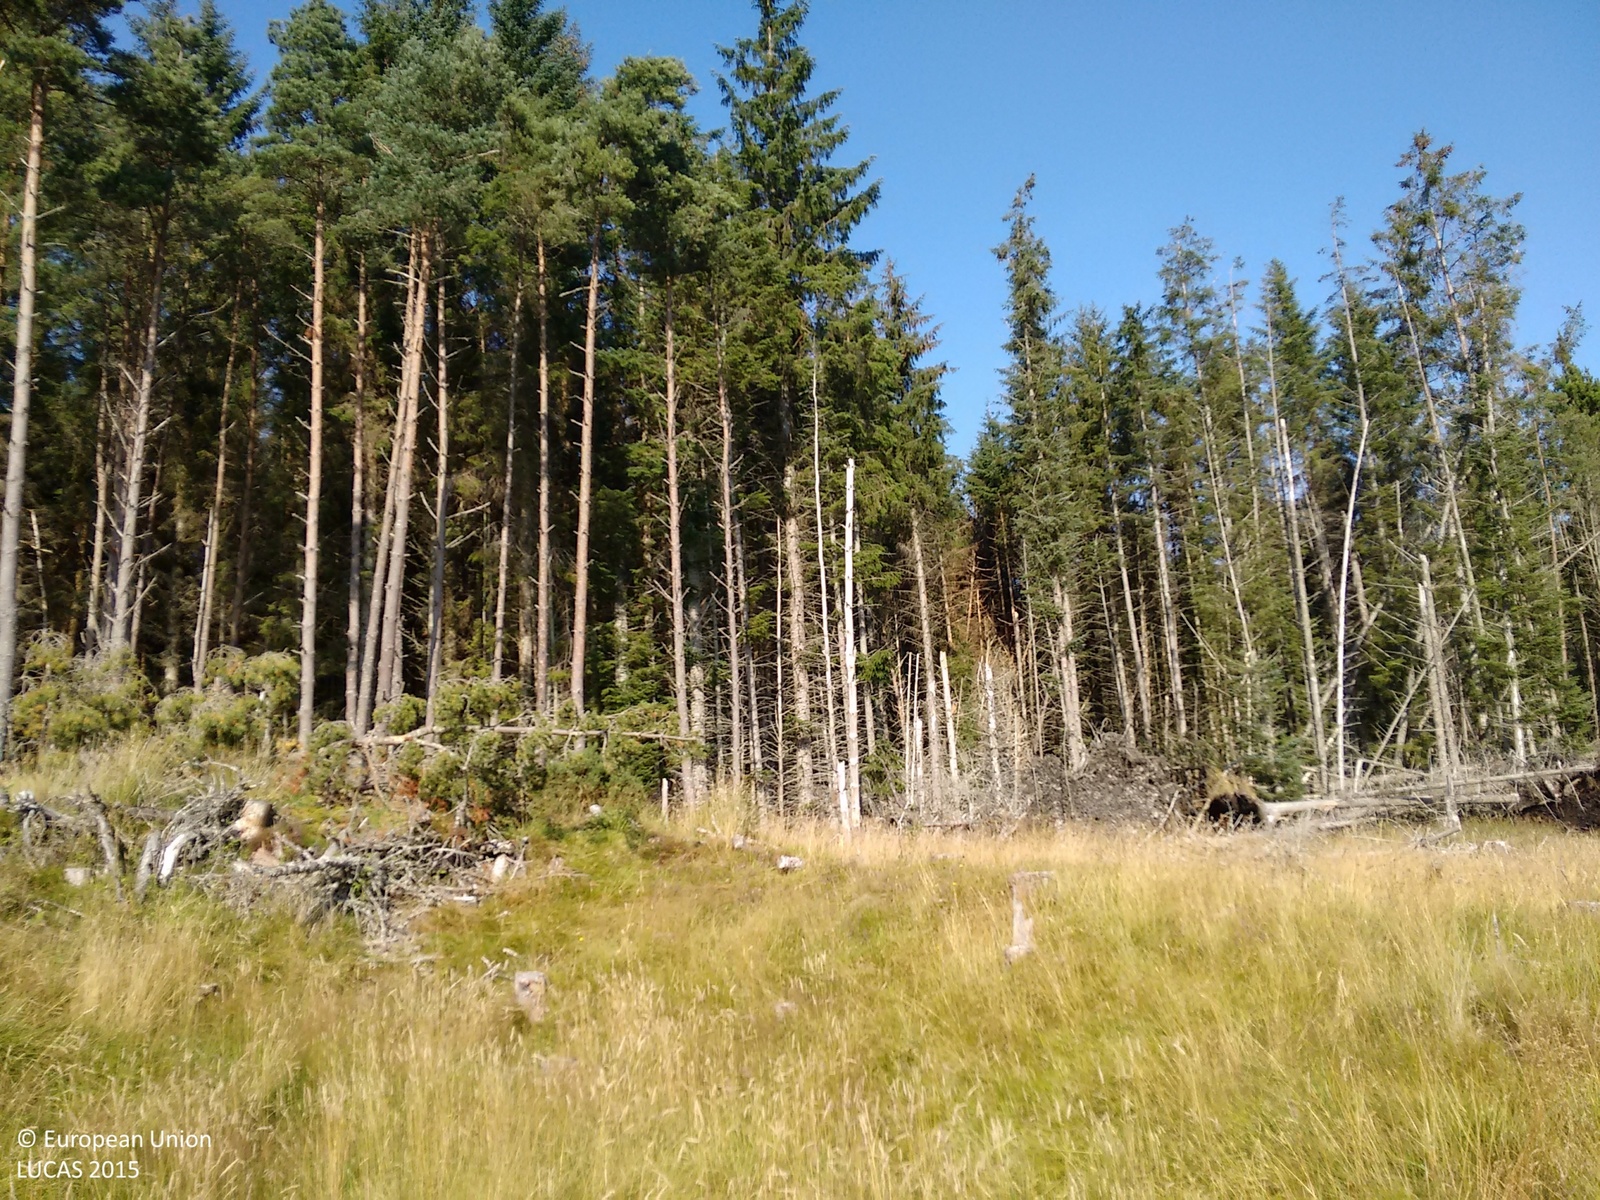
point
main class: Woodland
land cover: Pine dominated coniferous woodland
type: hemiboreal forest and nemoral coniferous forest and mixed broadleaved-coniferous forest
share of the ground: > 75 %
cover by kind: coniferous forest trees 100 %
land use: Forestry
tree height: > 5 m
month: September
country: GB
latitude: 58.3525
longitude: -4.2461
